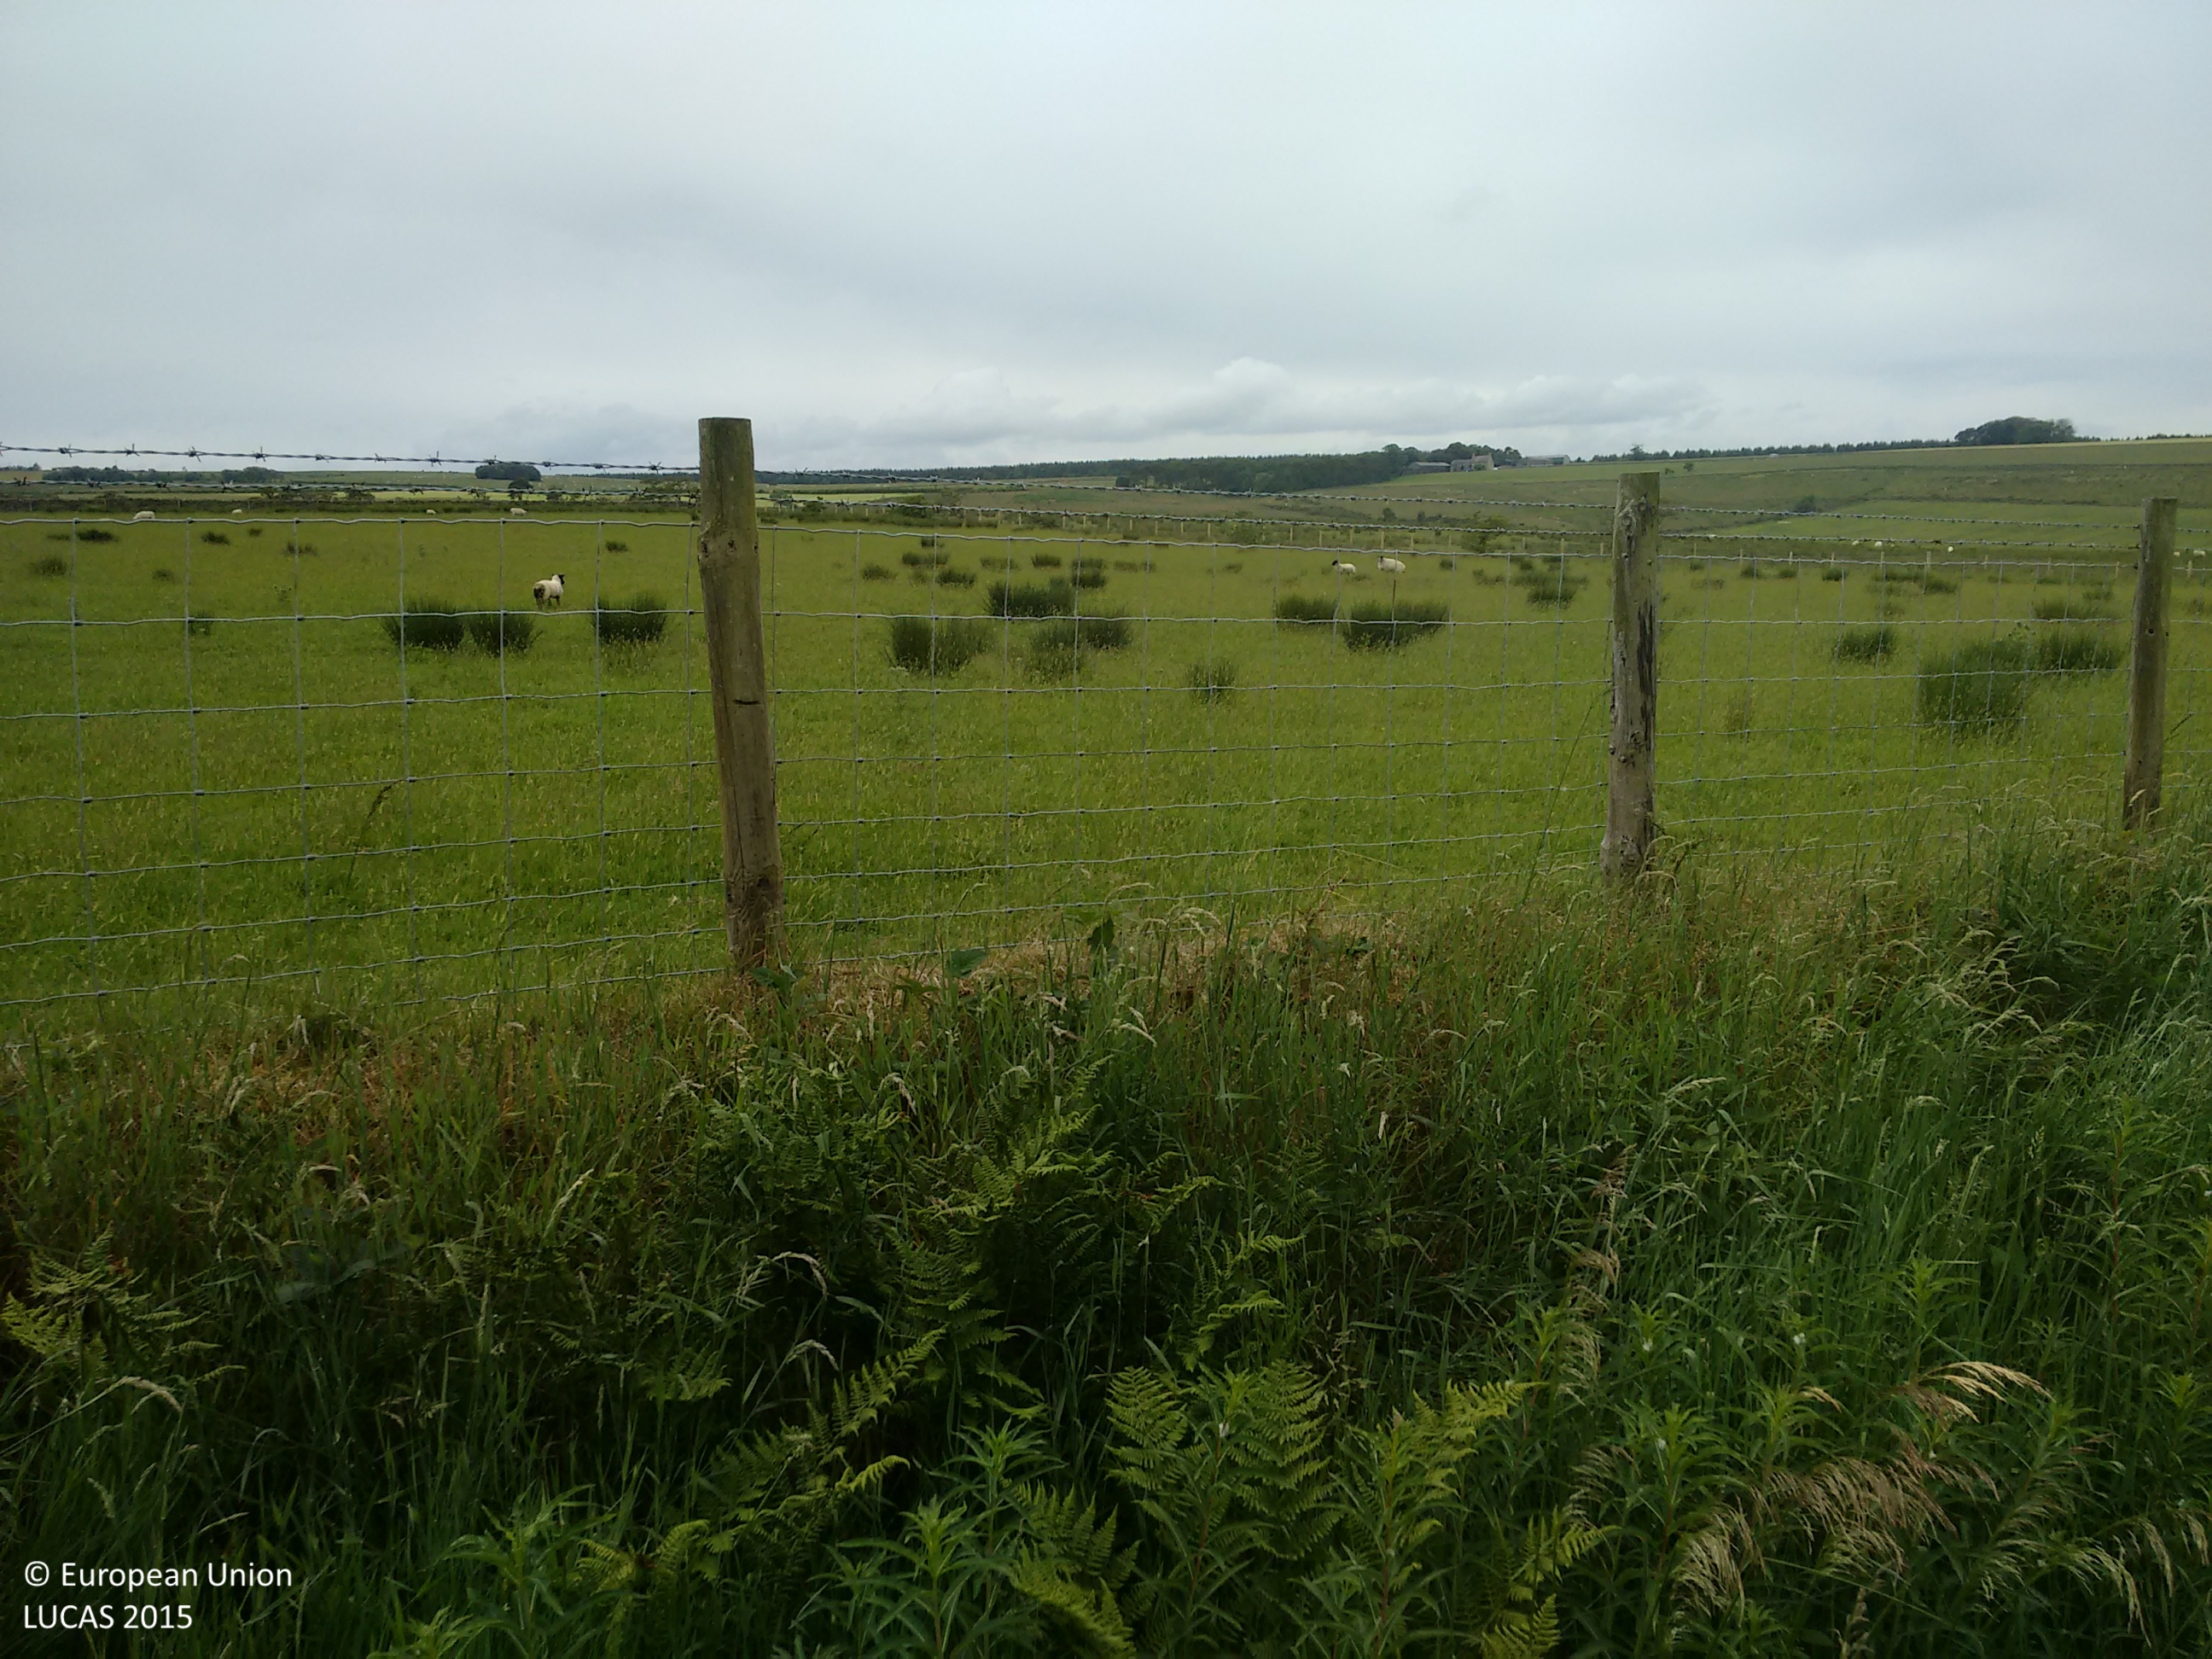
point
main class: Grassland
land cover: Grassland without tree/shrub cover
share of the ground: > 75 %
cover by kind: herbaceous plants 100 %
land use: Agriculture (excluding fallow land and kitchen gardens)
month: July
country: GB
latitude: 54.6513
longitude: -1.8791
